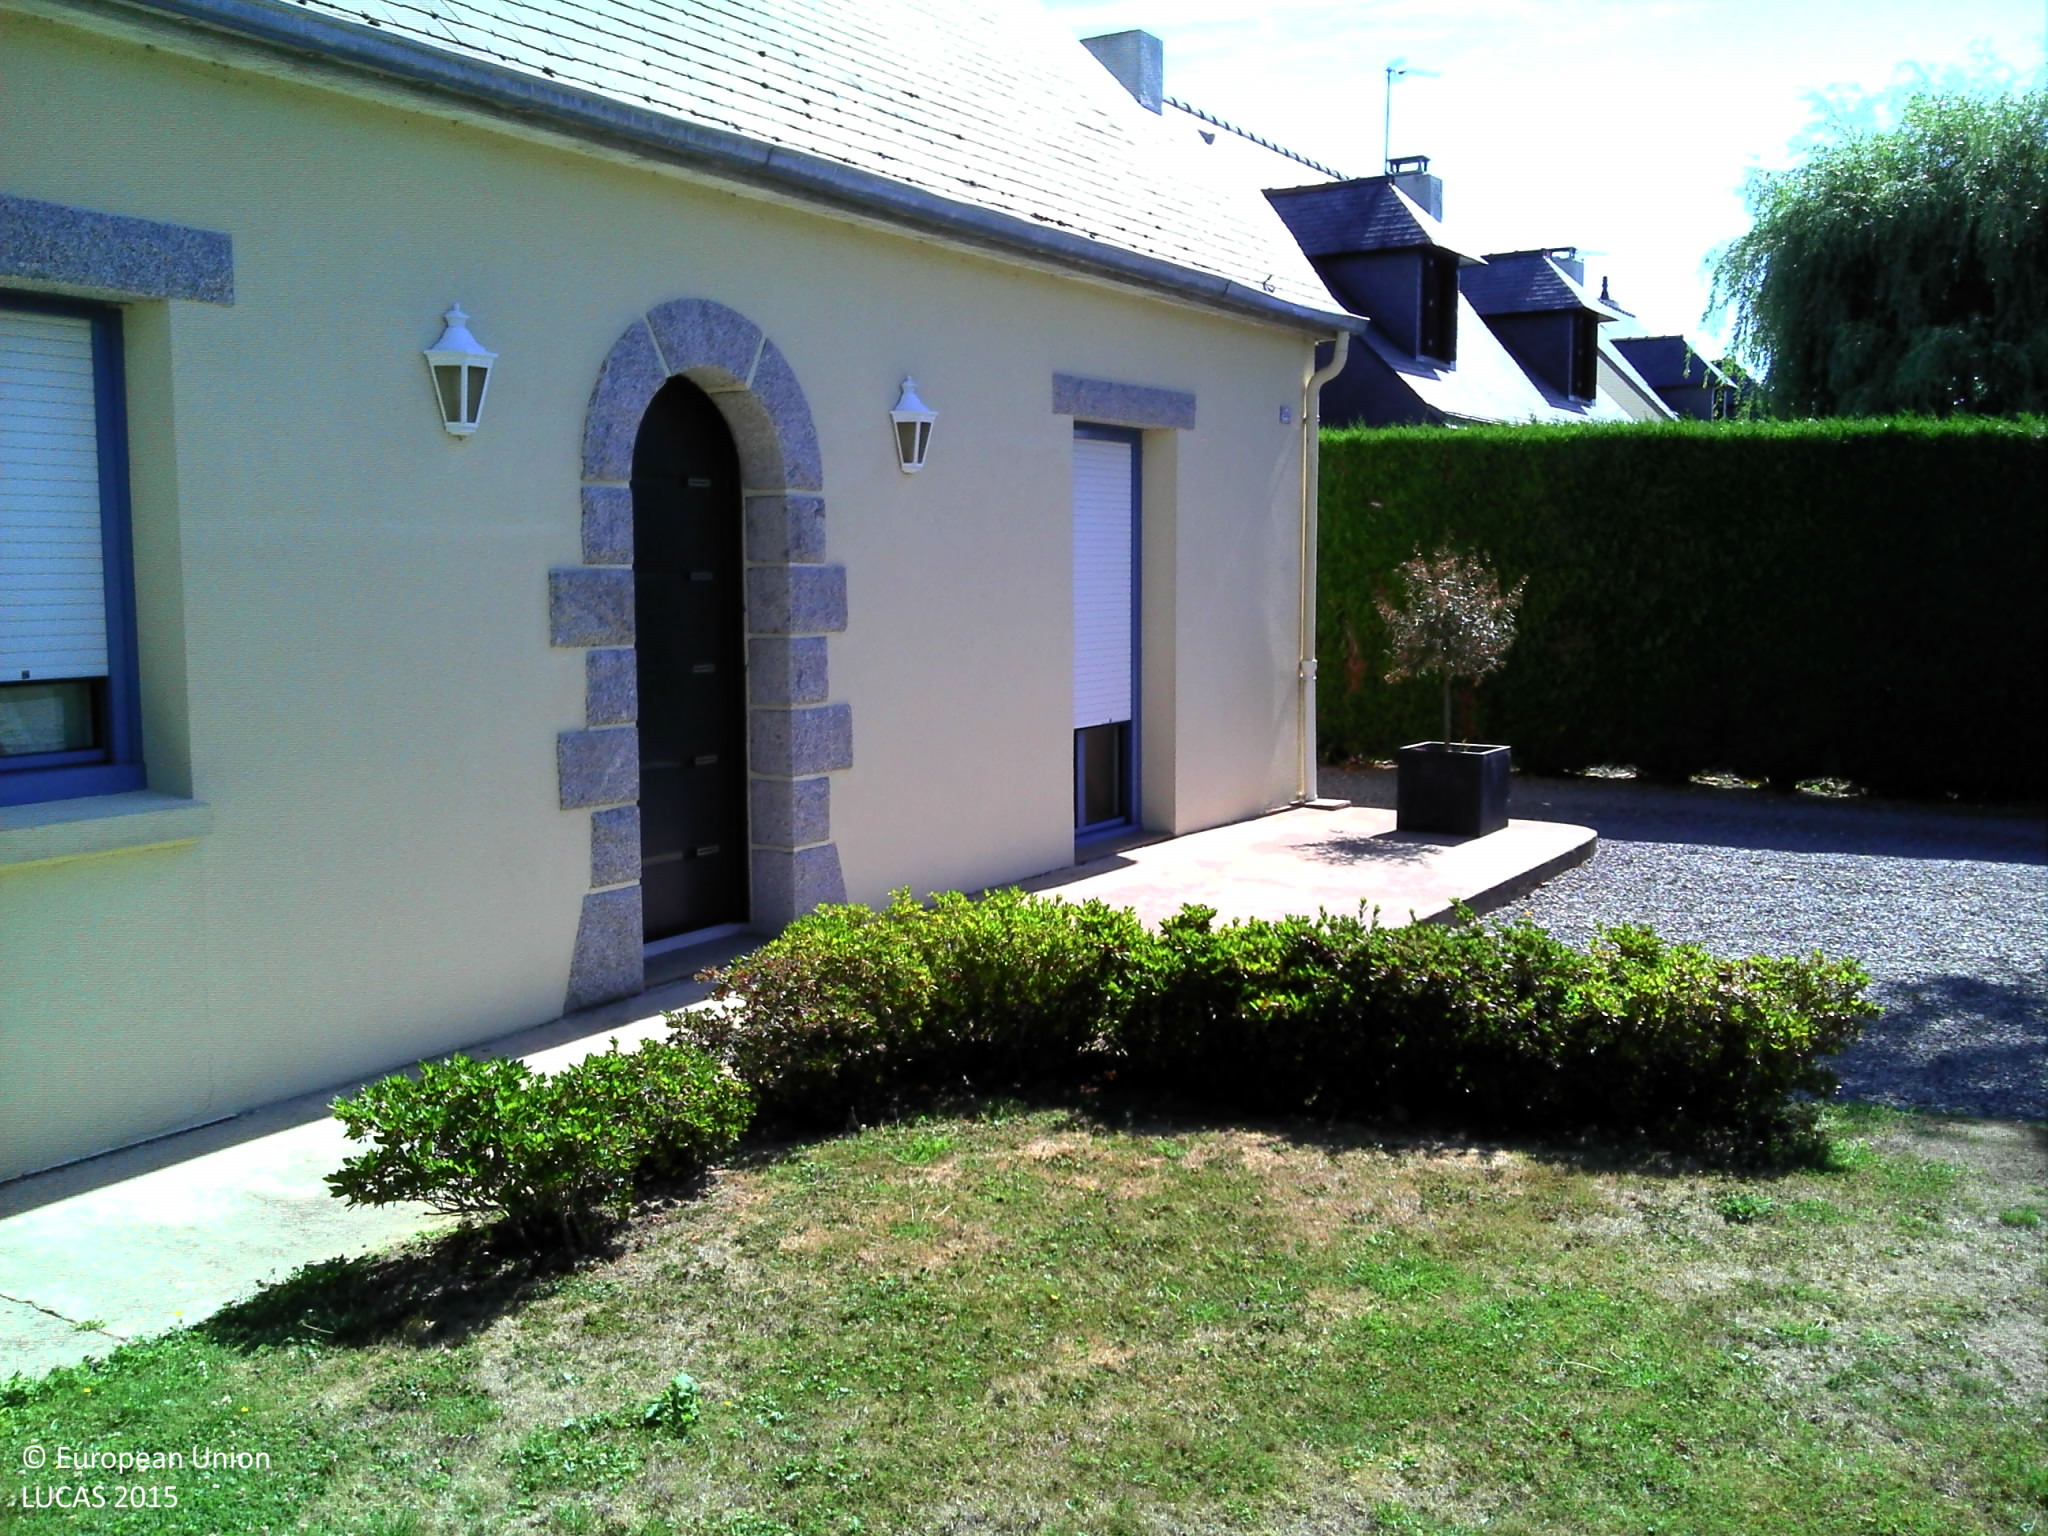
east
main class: Grassland
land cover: Grassland with sparse tree/shrub cover
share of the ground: > 75 %
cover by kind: herbaceous plants 95 %, broadleaved forest trees 5 %
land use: Residential
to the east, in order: Grassland with sparse tree/shrub cover; Artificial constructions in urban areas; Grassland with sparse tree/shrub cover
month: July
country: FR
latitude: 47.4445
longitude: -2.1053
